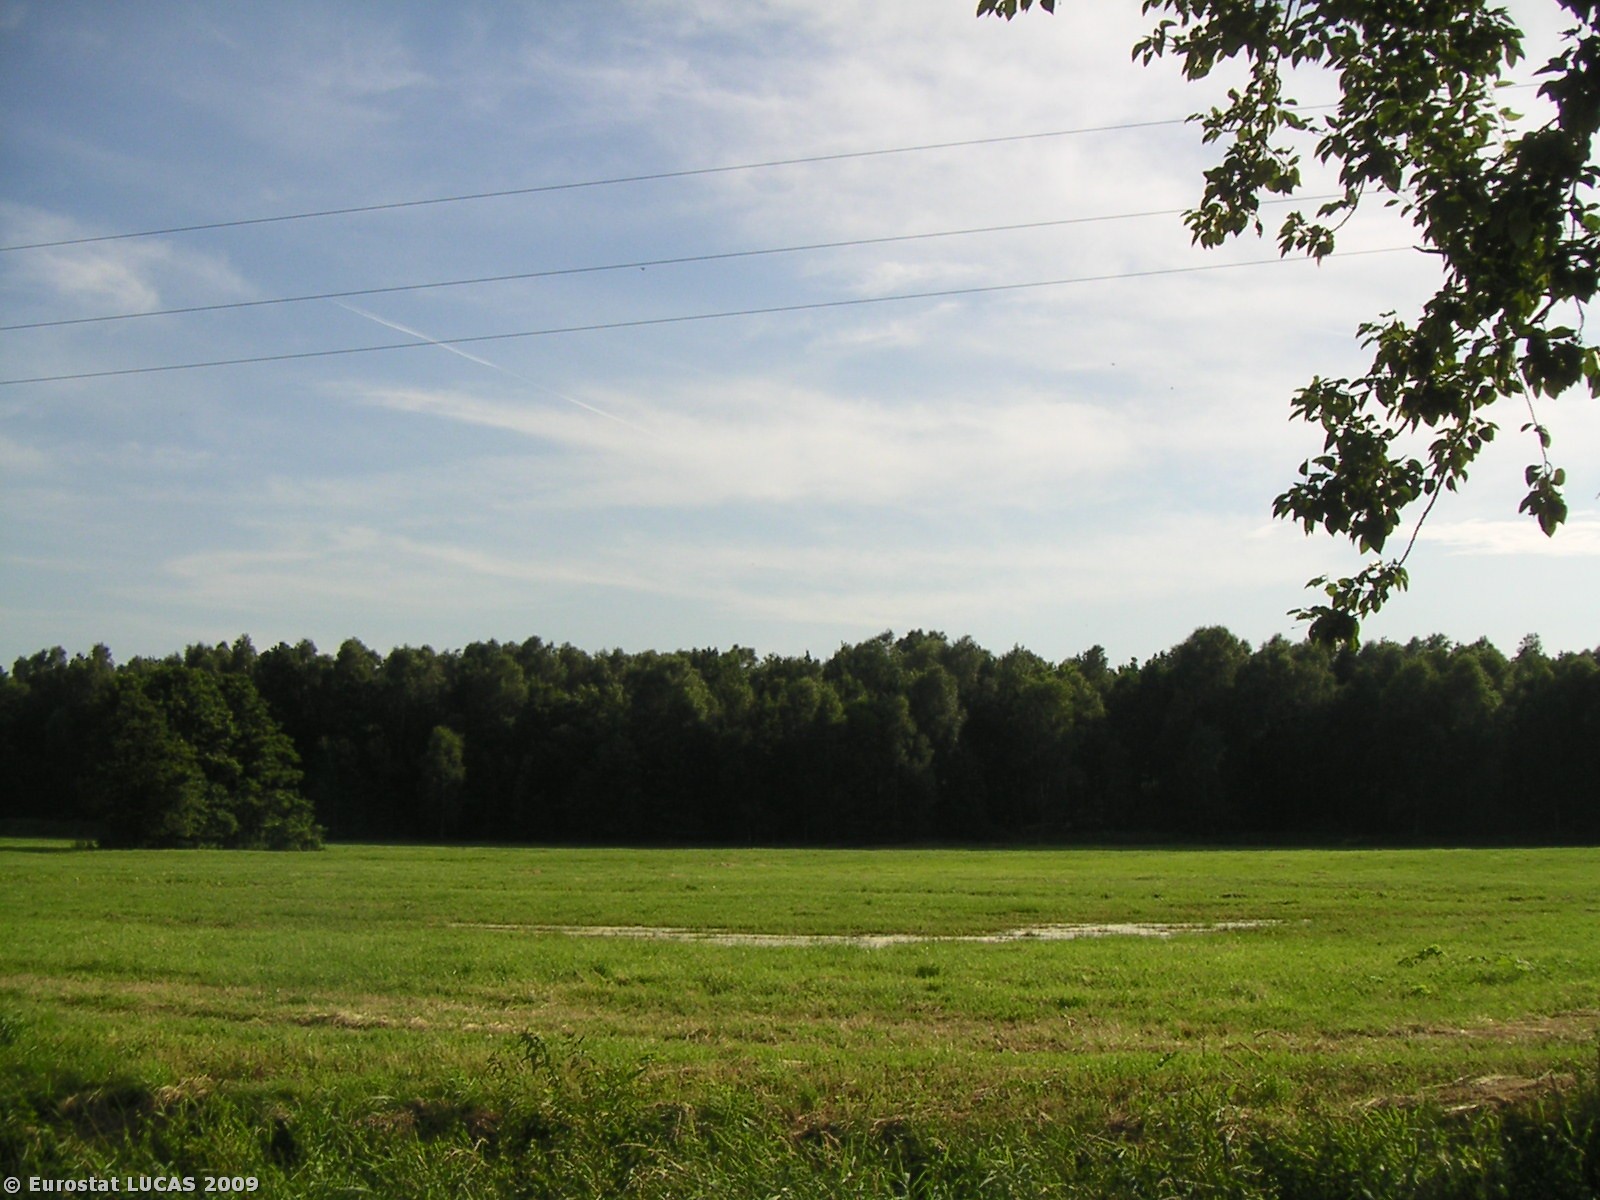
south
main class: Grassland
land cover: Grassland without tree/shrub cover
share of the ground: > 75 %
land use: Agriculture (excluding fallow land and kitchen gardens)
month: July
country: PL
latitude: 50.2226
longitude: 18.8096
